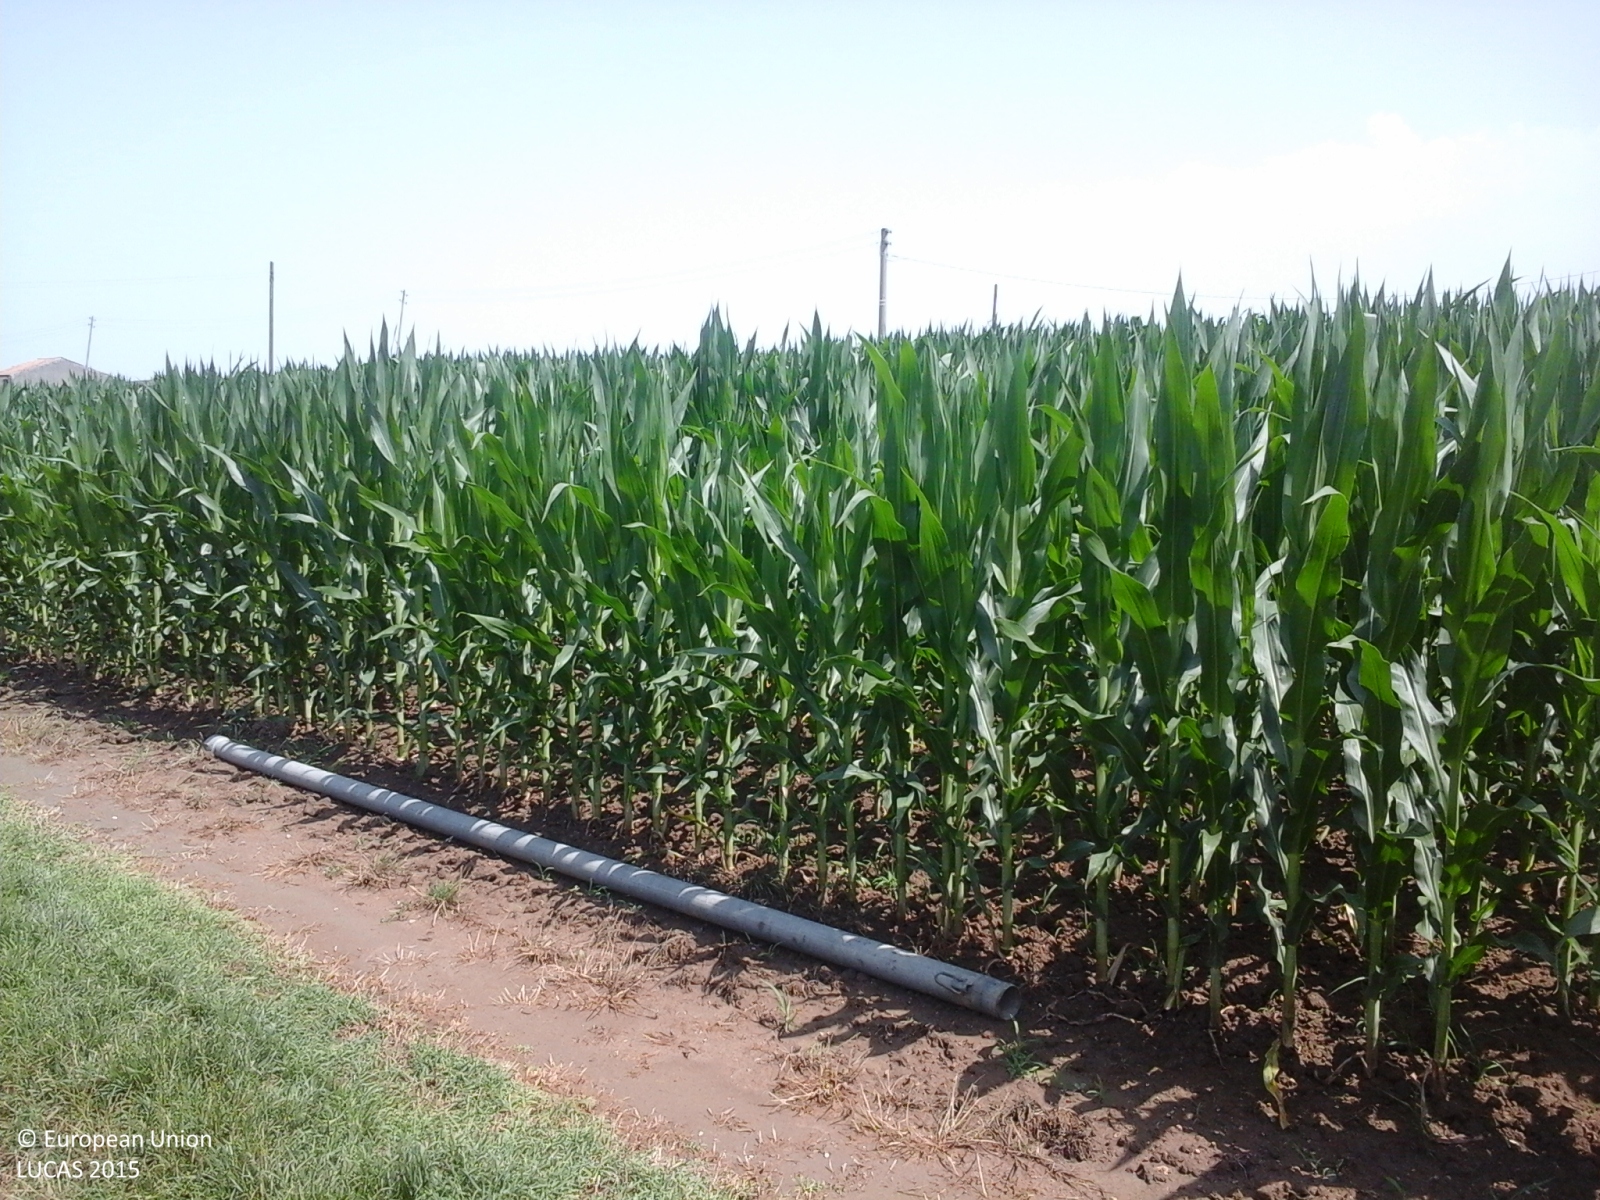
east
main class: Cropland
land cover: Maize
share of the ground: > 75 %
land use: Agriculture (excluding fallow land and kitchen gardens)
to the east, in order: Maize; Other fresh vegetables; Maize; Ditches and canals; Tracks; Grass margins; Electric lines; Tobacco; Electric lines; Fences; Grass margins; Paved roads, cycling and walking lanes; Grass margins; Electric lines; Inland fresh running water; Tobacco
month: June
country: IT
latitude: 45.2463
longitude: 11.1064
